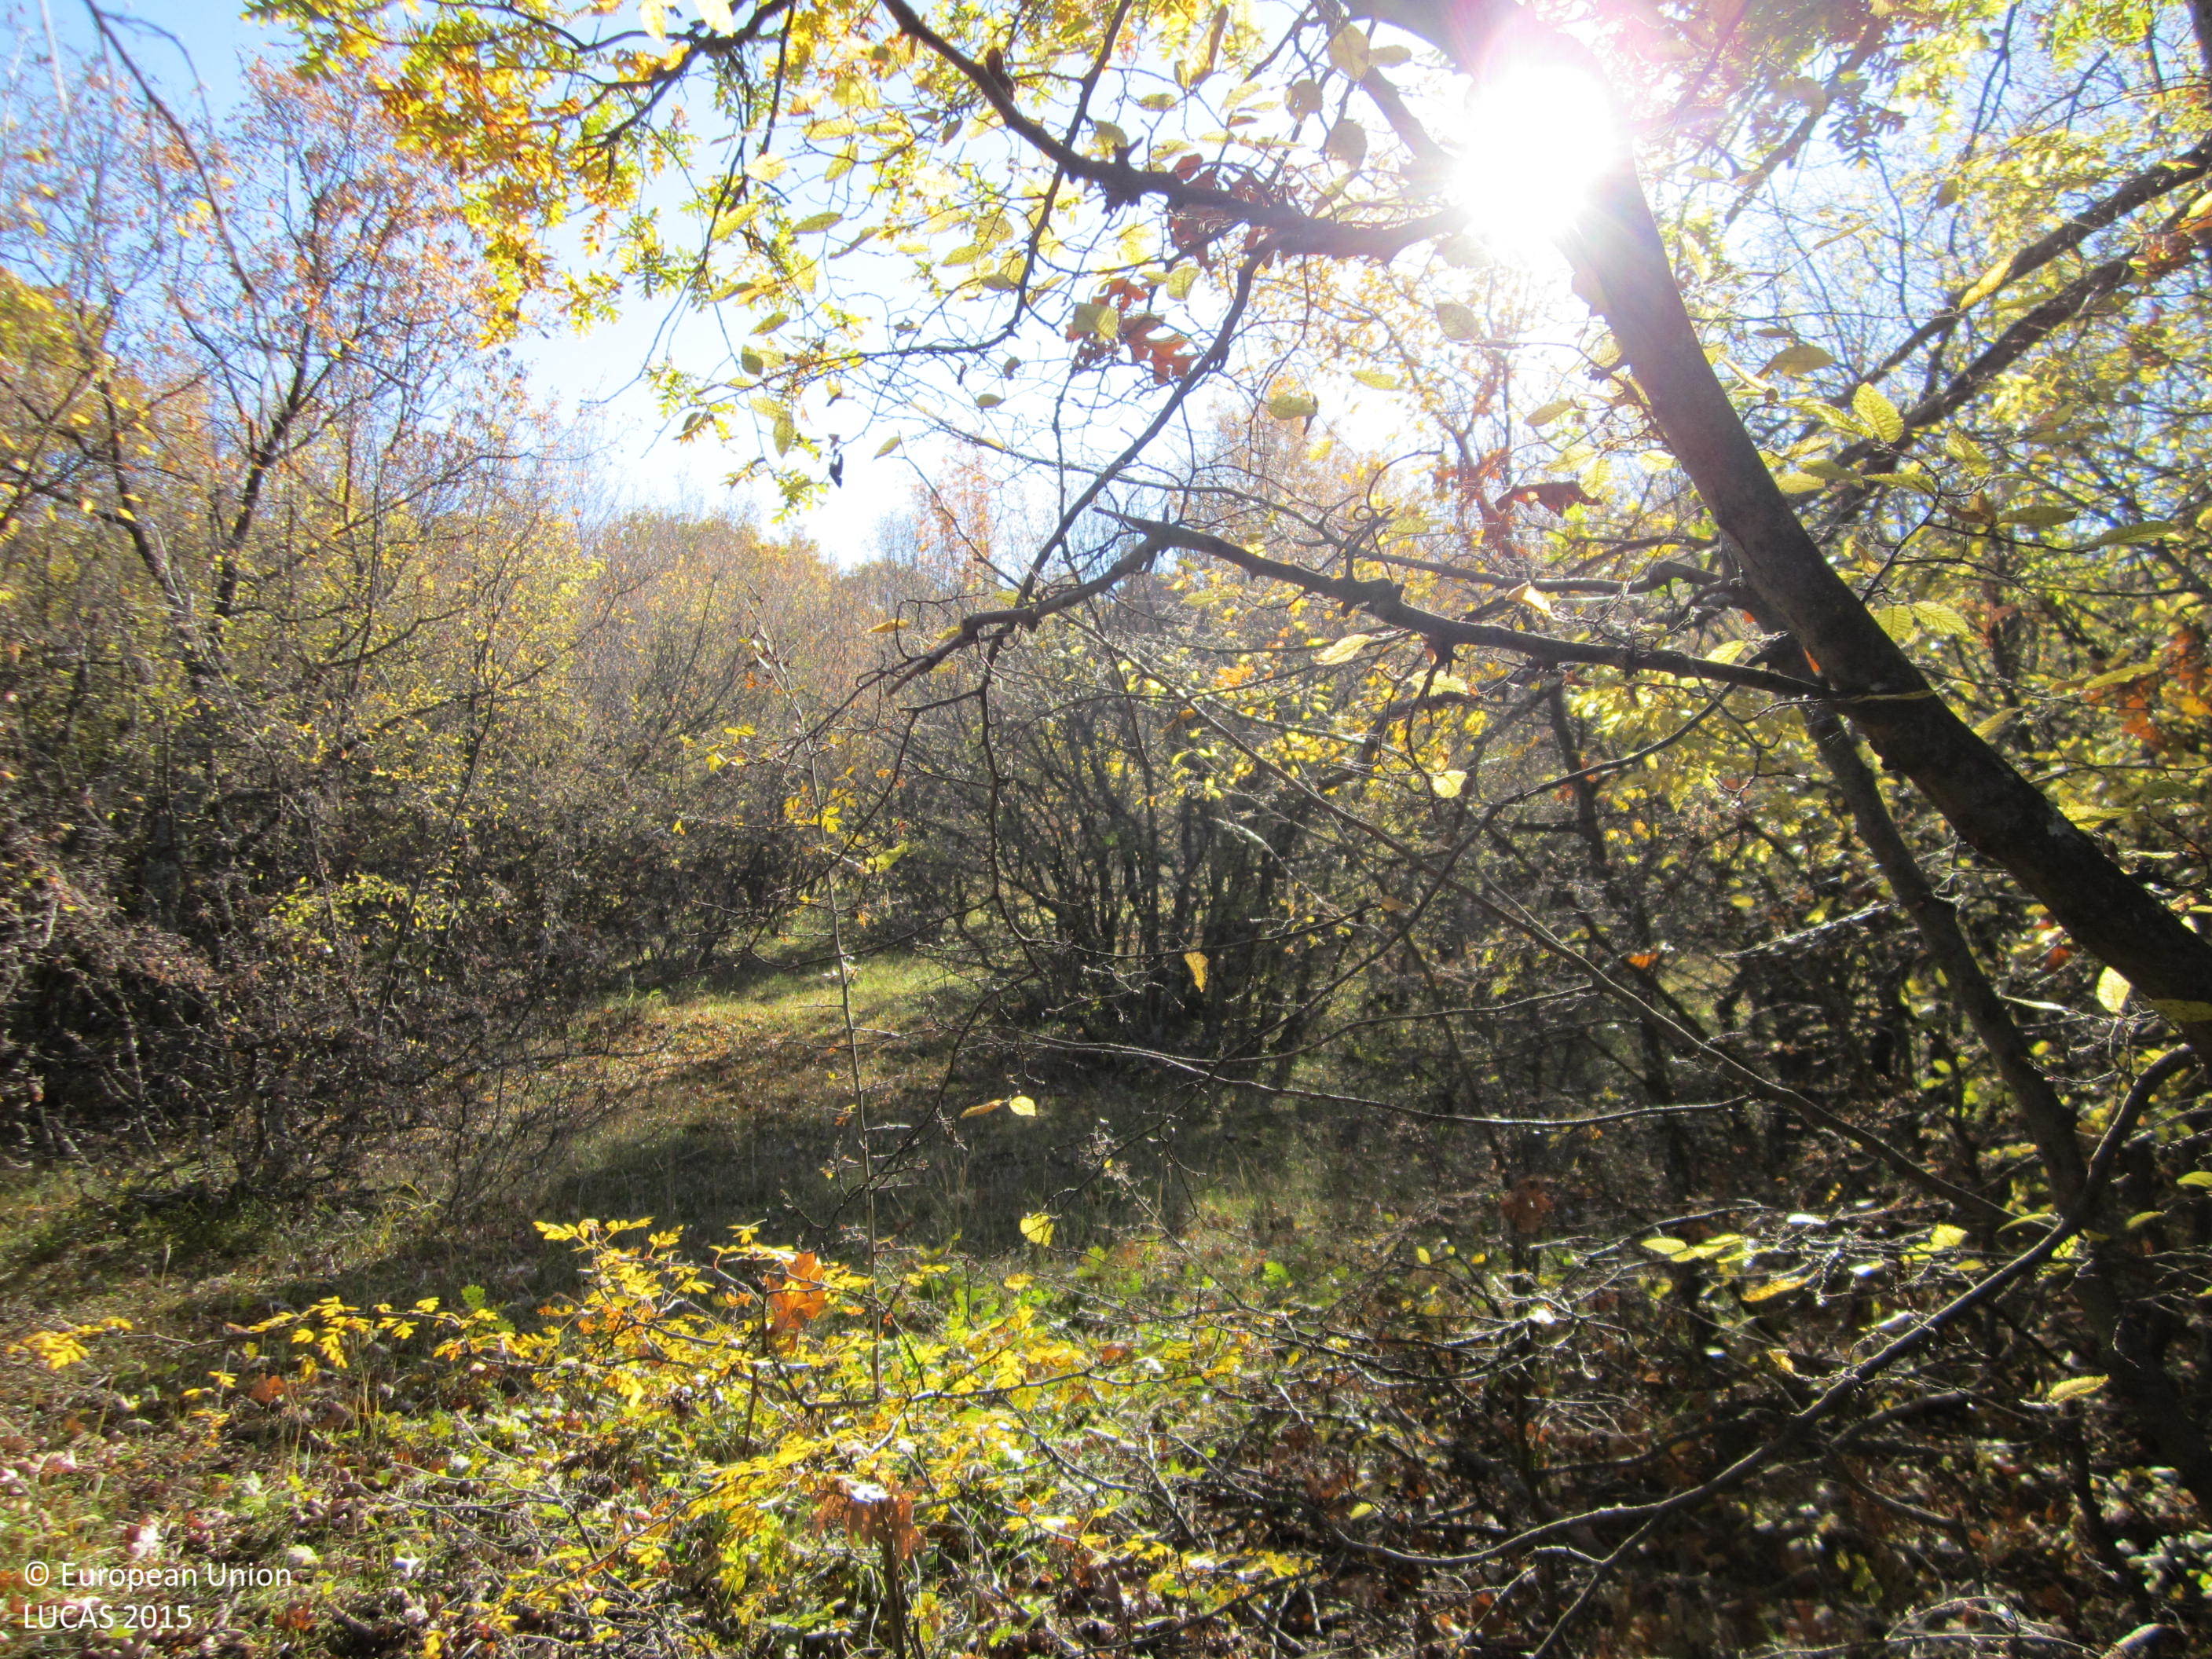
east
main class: Woodland
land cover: Broadleaved woodland
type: mesophytic deciduous forest
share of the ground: > 75 %
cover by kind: broadleaved forest trees 80 %, herbaceous plants 15 %, shrubs 5 %
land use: Forestry
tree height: > 5 m
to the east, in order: Broadleaved woodland; Rocks and stones; Broadleaved woodland; Rocks and stones; Tracks; Rock outcrops; Tracks; Rocks and stones; Grassland with sparse tree/shrub cover
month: November
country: BG
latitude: 41.4878
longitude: 25.7404
